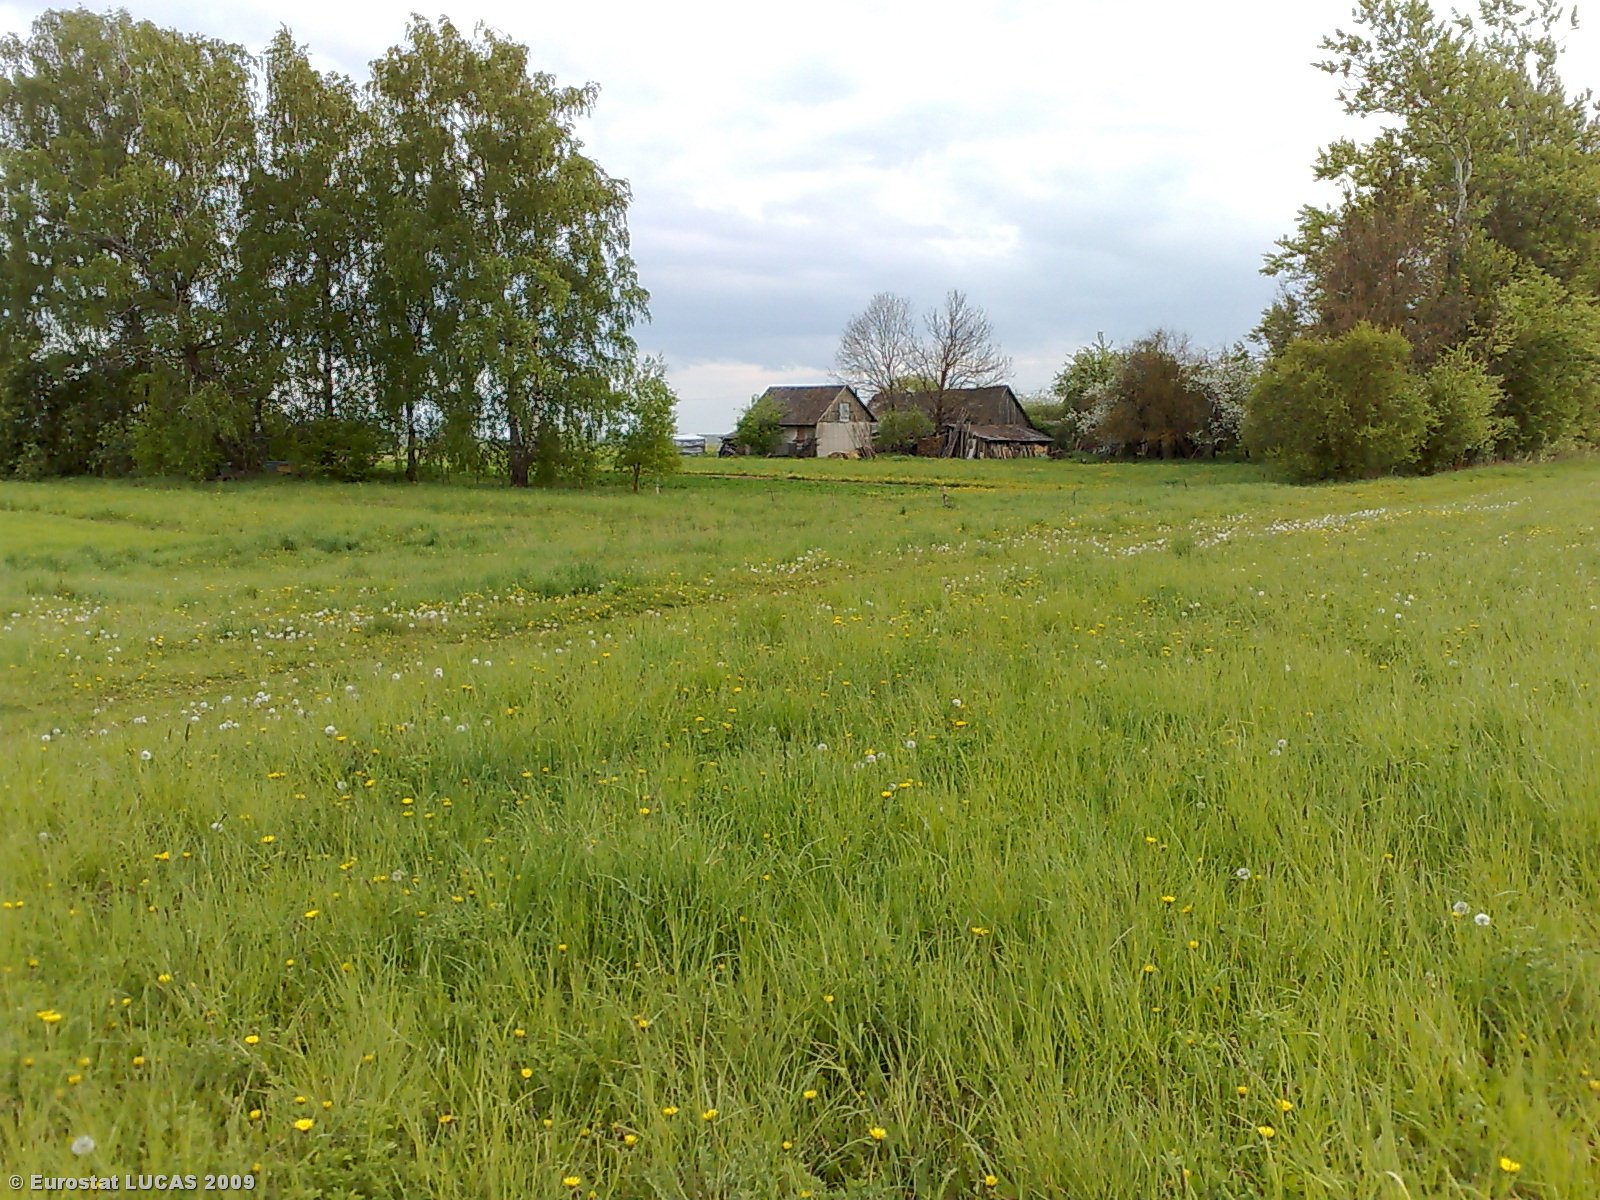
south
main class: Grassland
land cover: Grassland without tree/shrub cover
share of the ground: > 75 %
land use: Agriculture (excluding fallow land and kitchen gardens)
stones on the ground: < 10 %
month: May
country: LT
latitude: 55.6567
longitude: 23.9632
